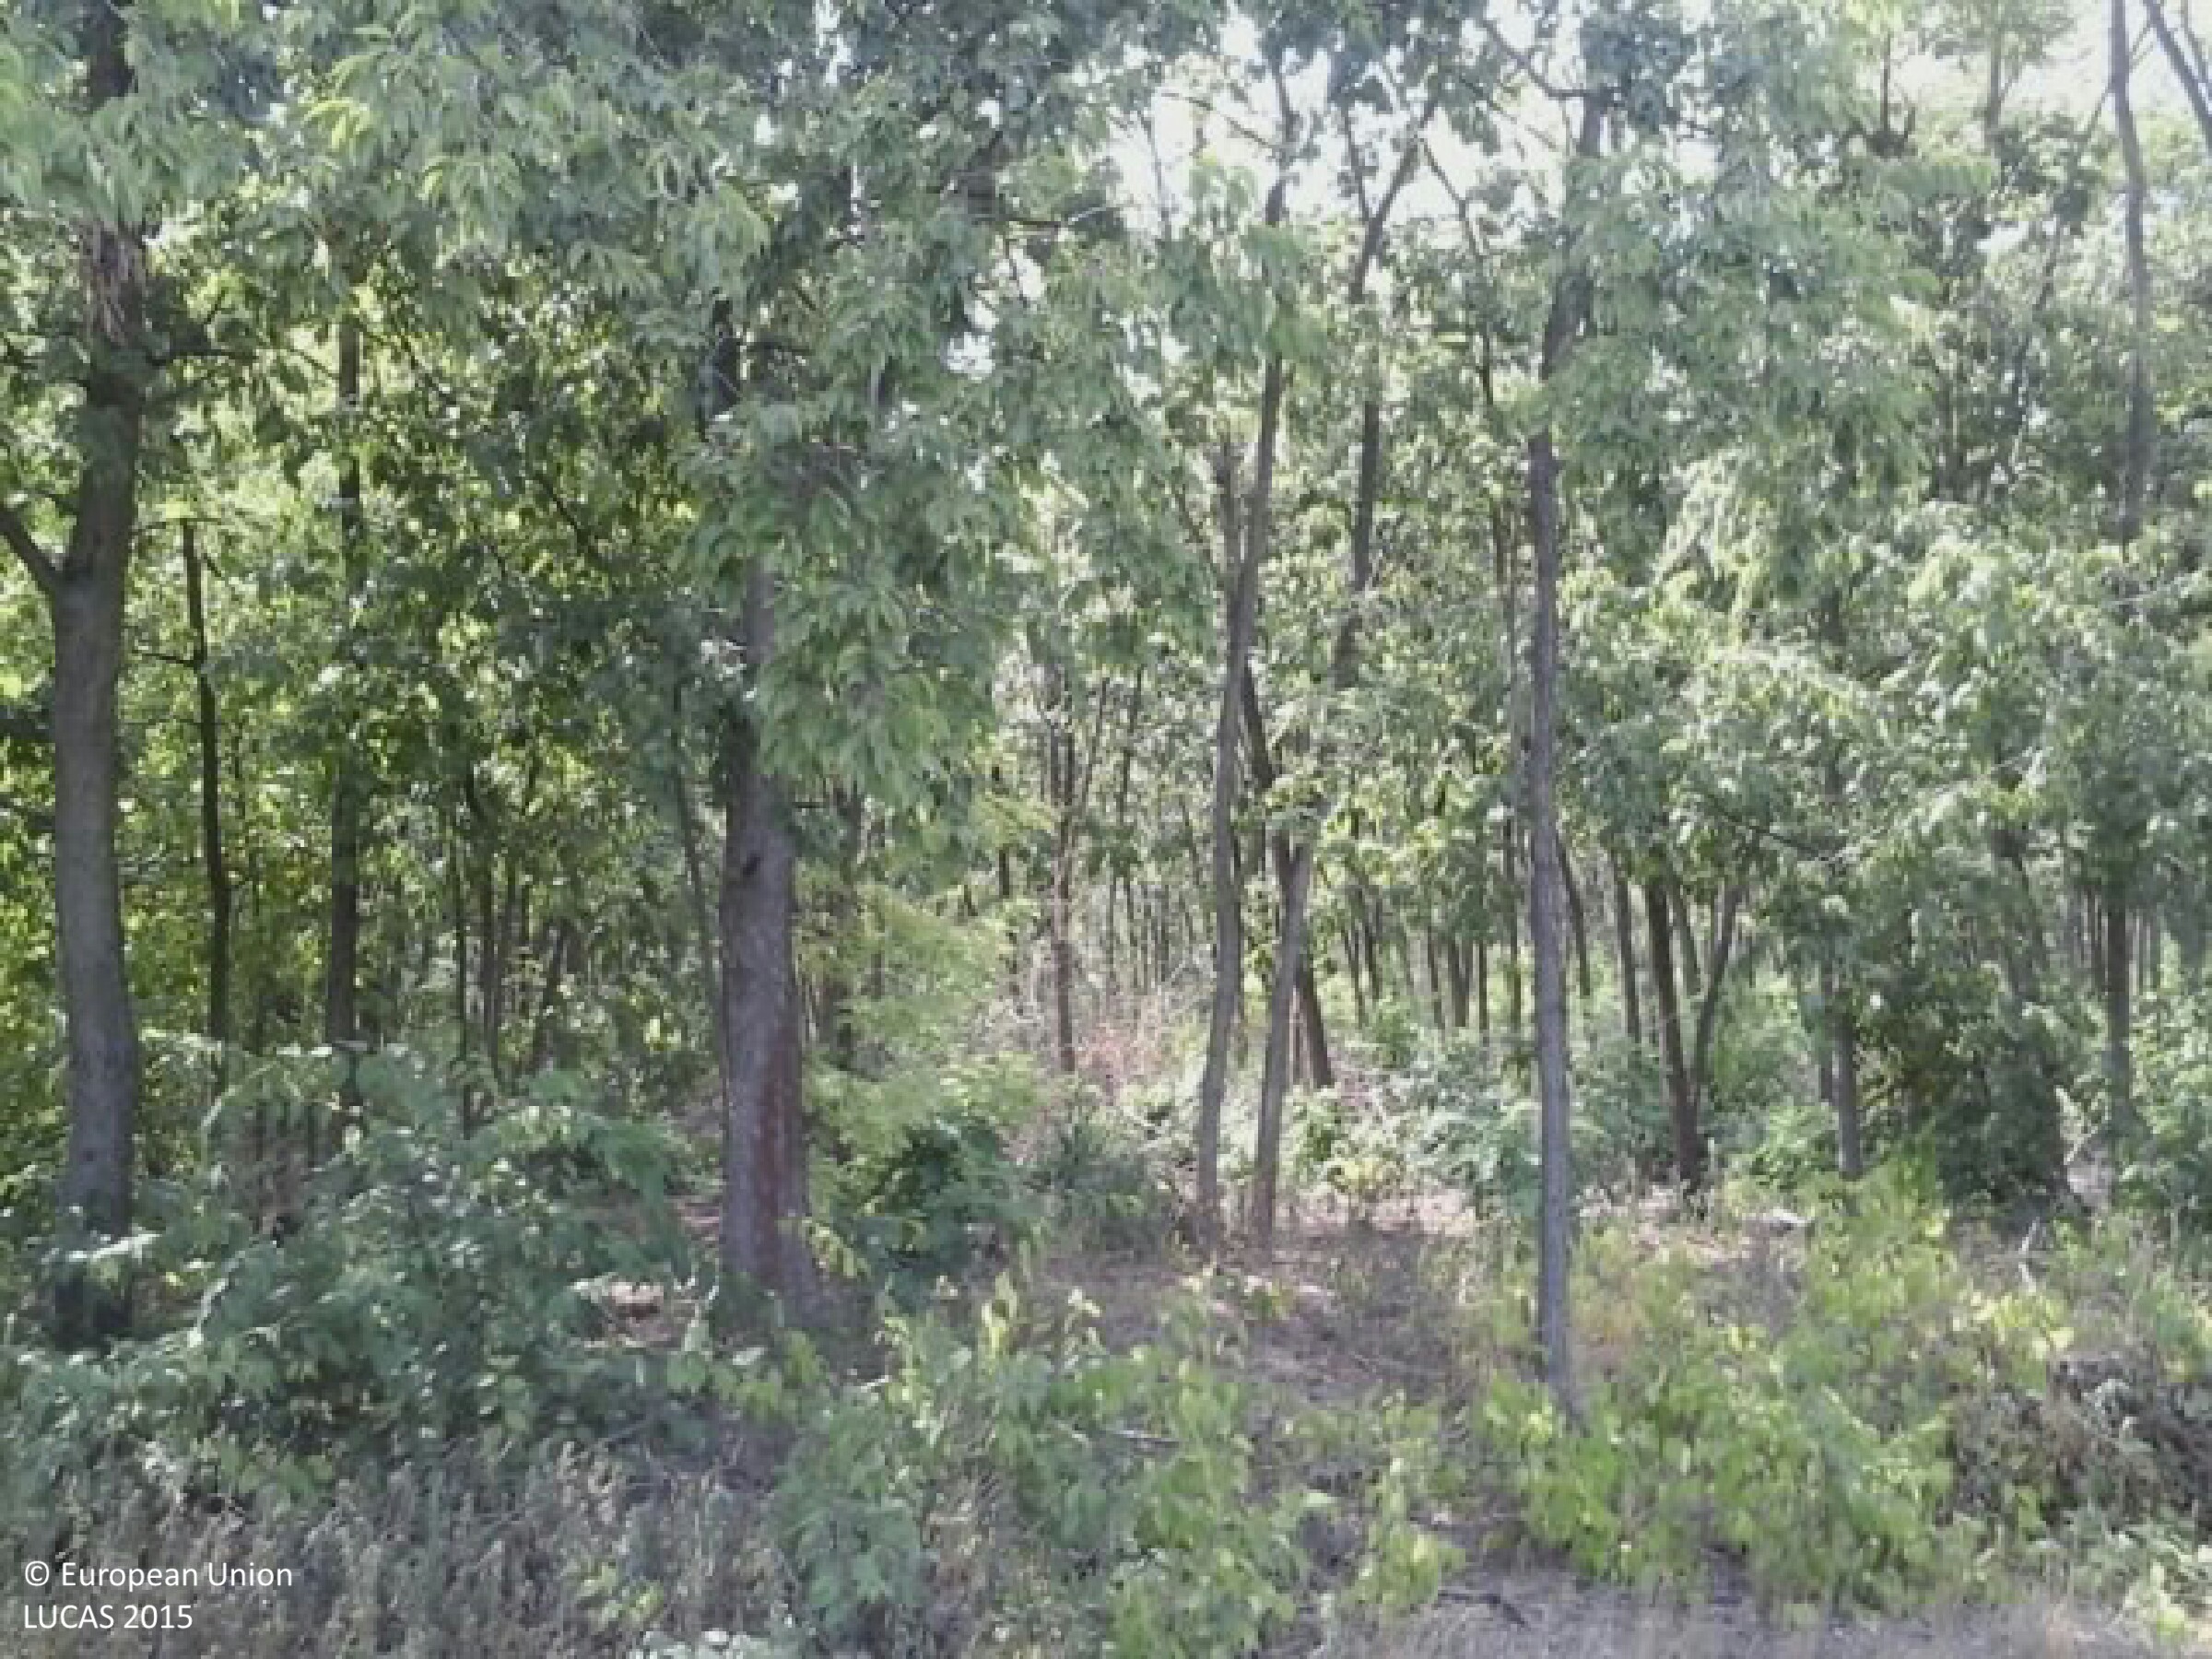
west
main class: Shrubland
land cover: Shrubland without tree cover
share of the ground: > 75 %
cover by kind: shrubs 85 %, herbaceous plants 15 %
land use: Semi-natural and natural areas not in use
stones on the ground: < 10 %
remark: Clear cut
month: August
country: HU
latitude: 47.1556
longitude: 19.3437
